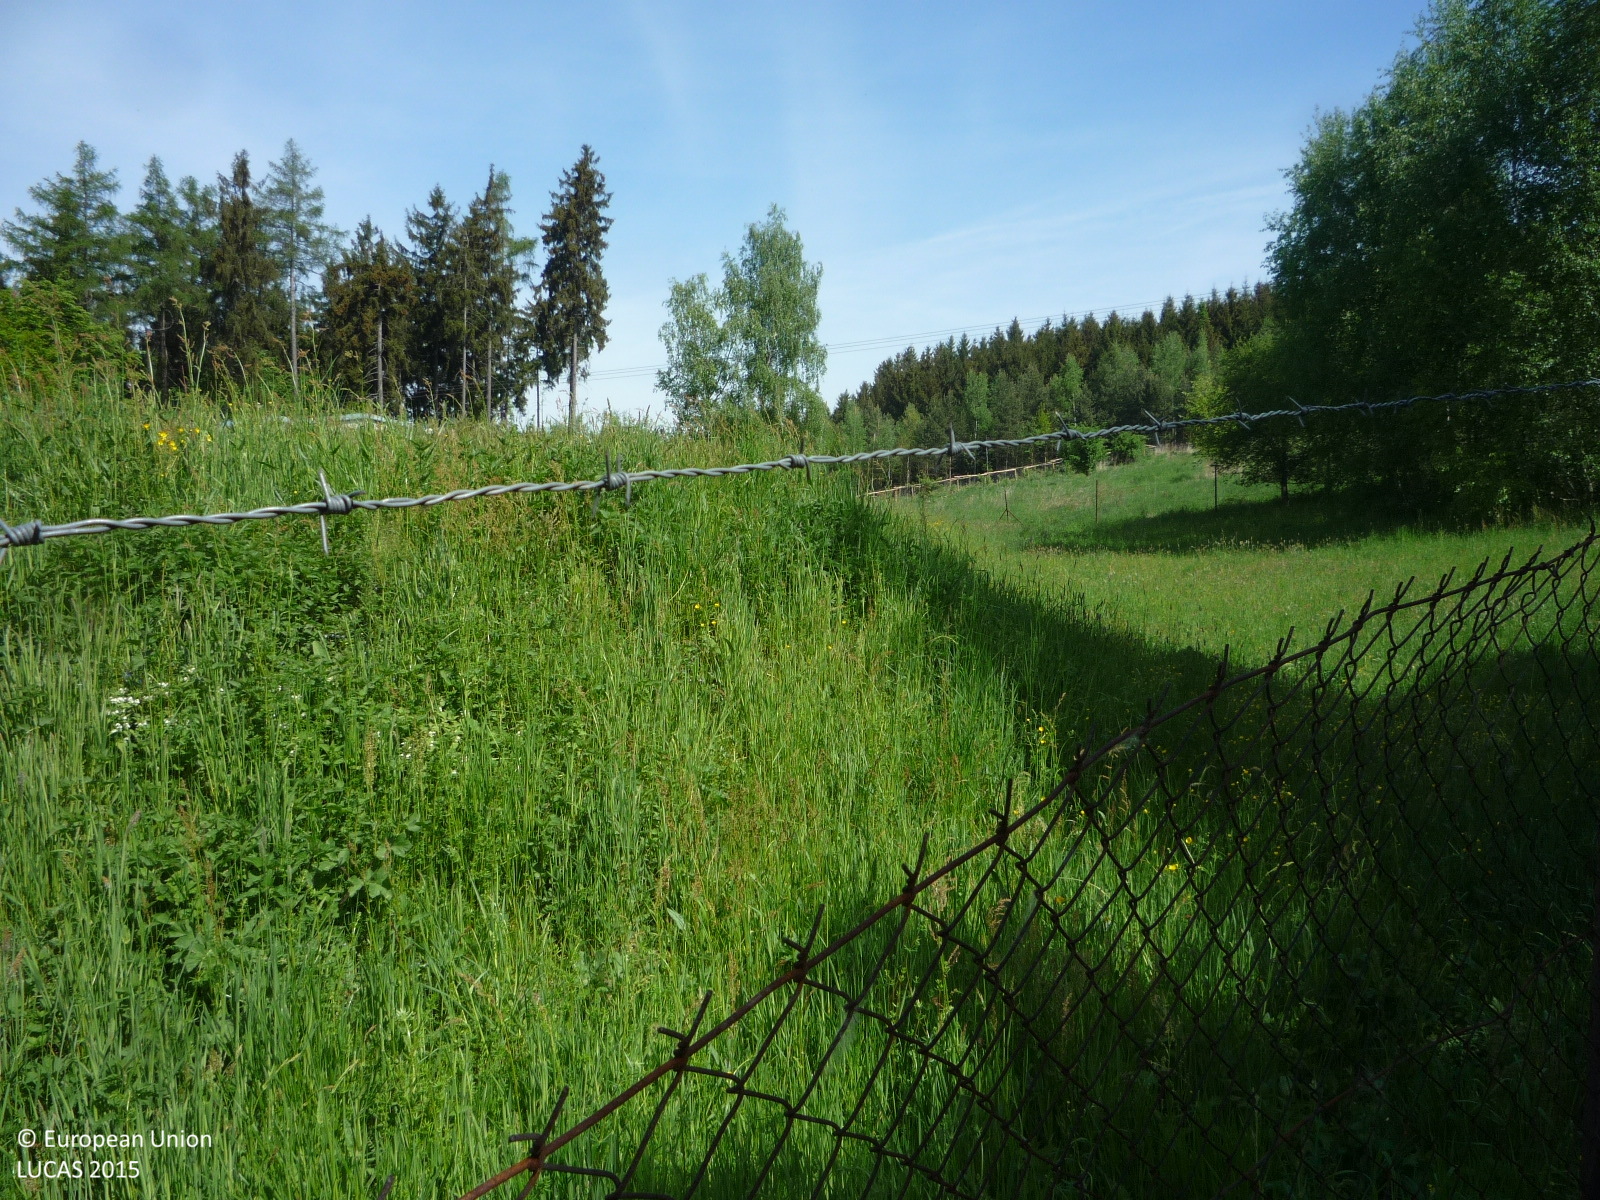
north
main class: Grassland
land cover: Grassland without tree/shrub cover
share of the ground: > 75 %
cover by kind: herbaceous plants 100 %
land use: Water supply and treatment
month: May
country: CZ
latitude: 49.9277
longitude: 14.6407
